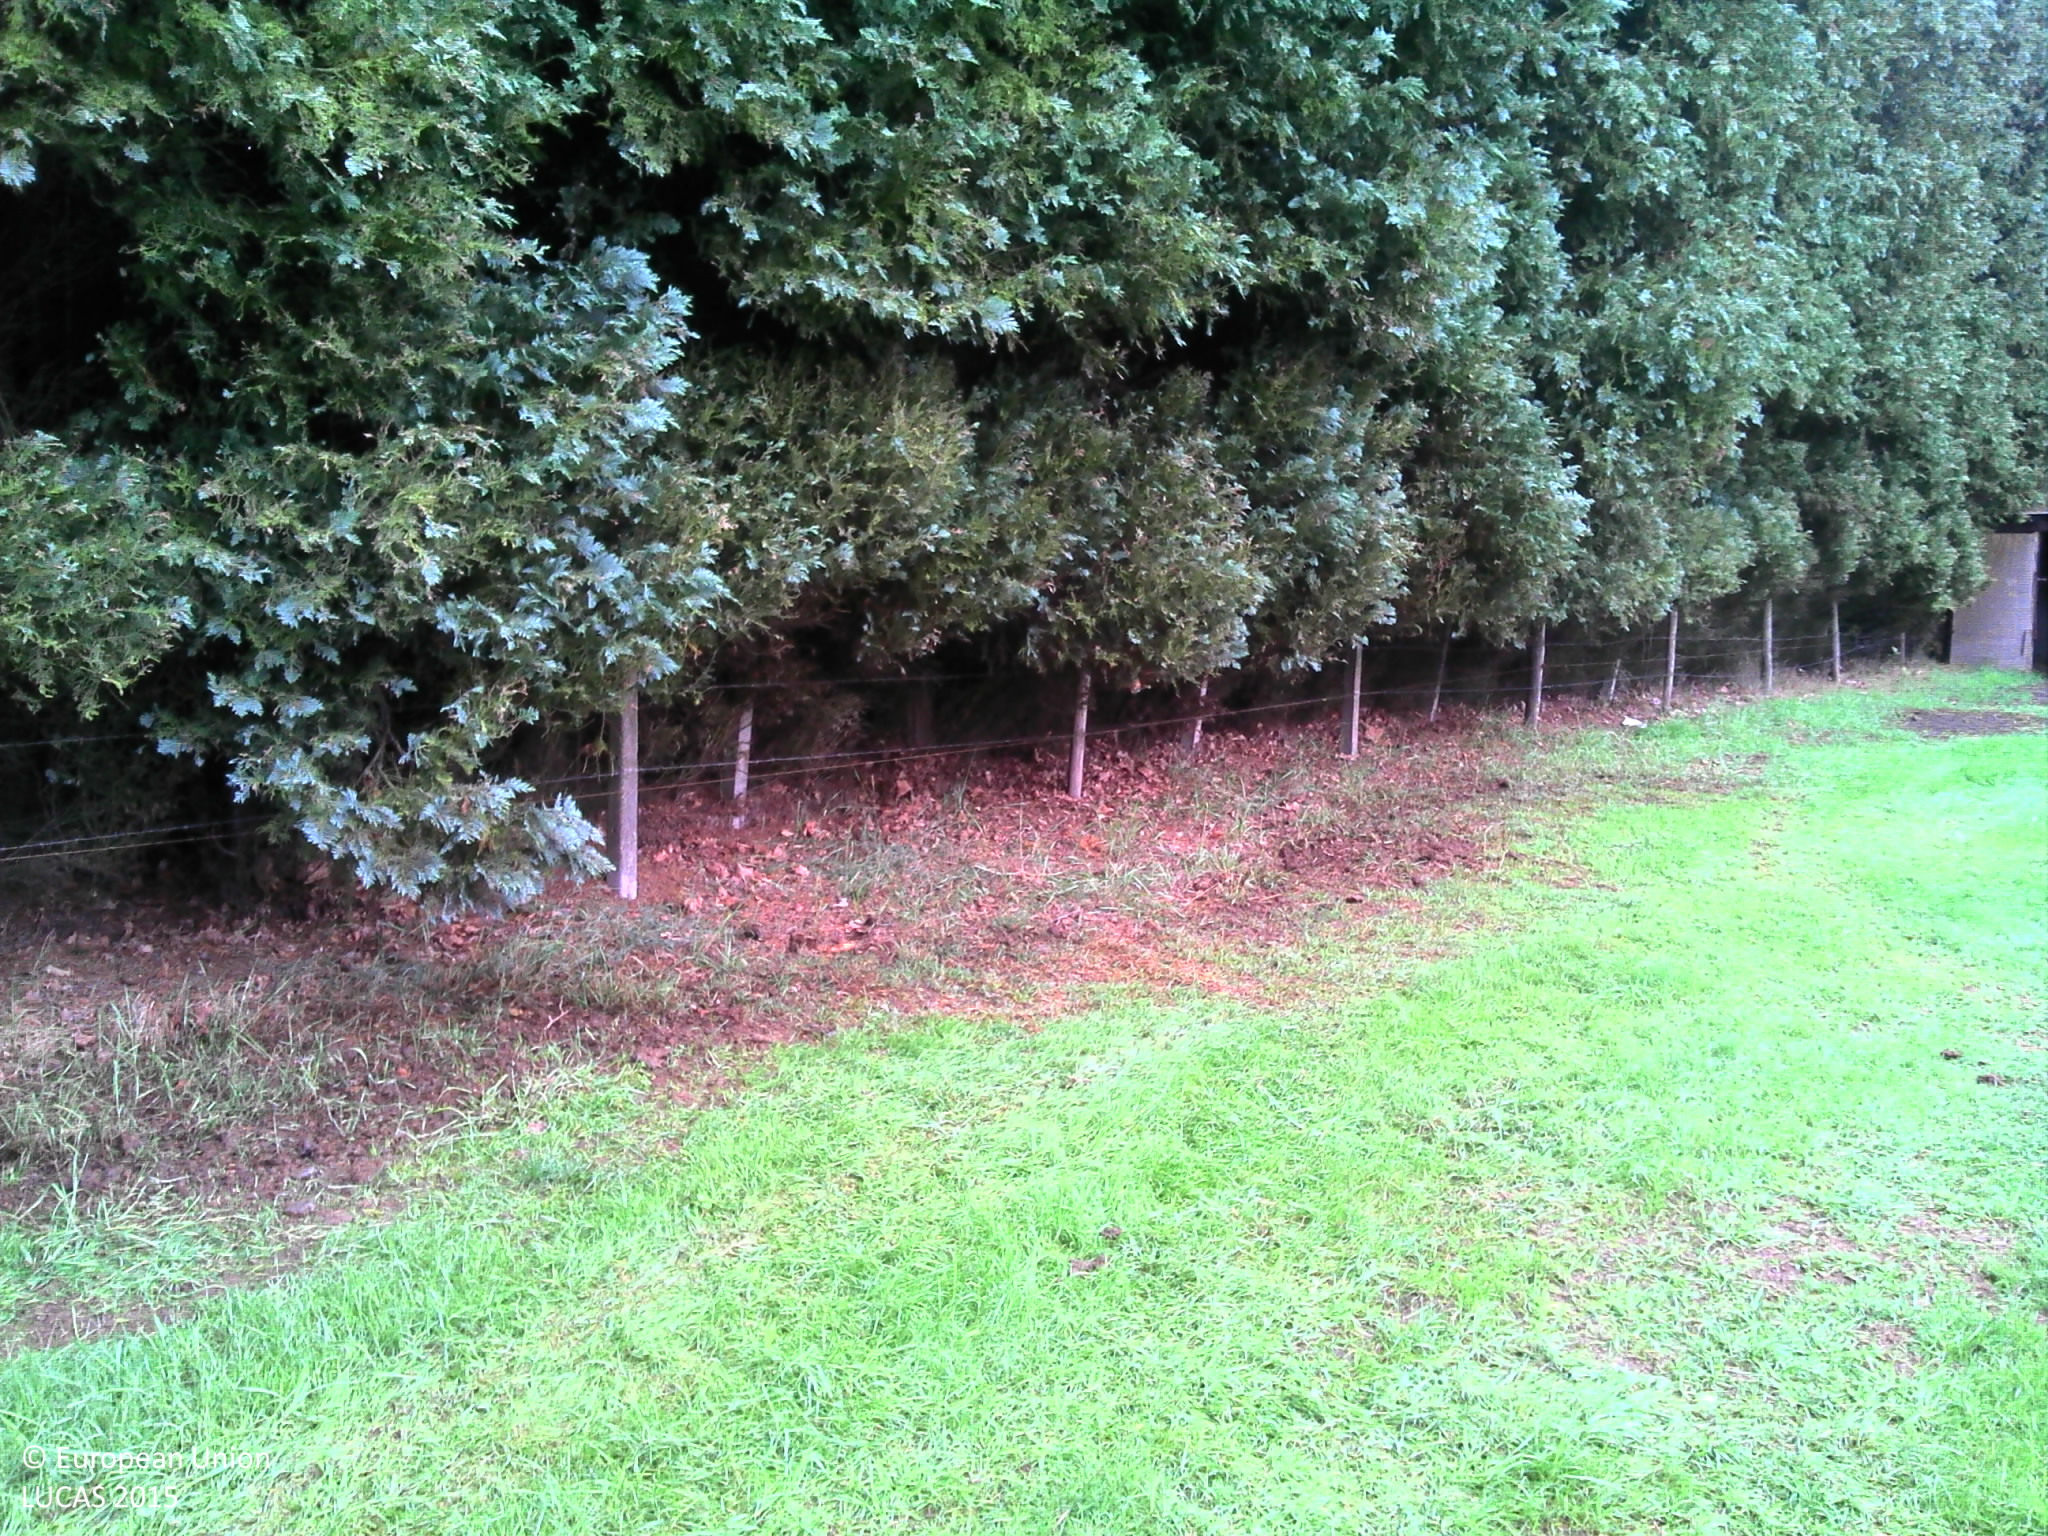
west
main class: Grassland
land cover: Grassland without tree/shrub cover
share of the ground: > 75 %
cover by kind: herbaceous plants 100 %
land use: Agriculture (excluding fallow land and kitchen gardens)
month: August
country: BE
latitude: 51.3041
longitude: 5.1061
